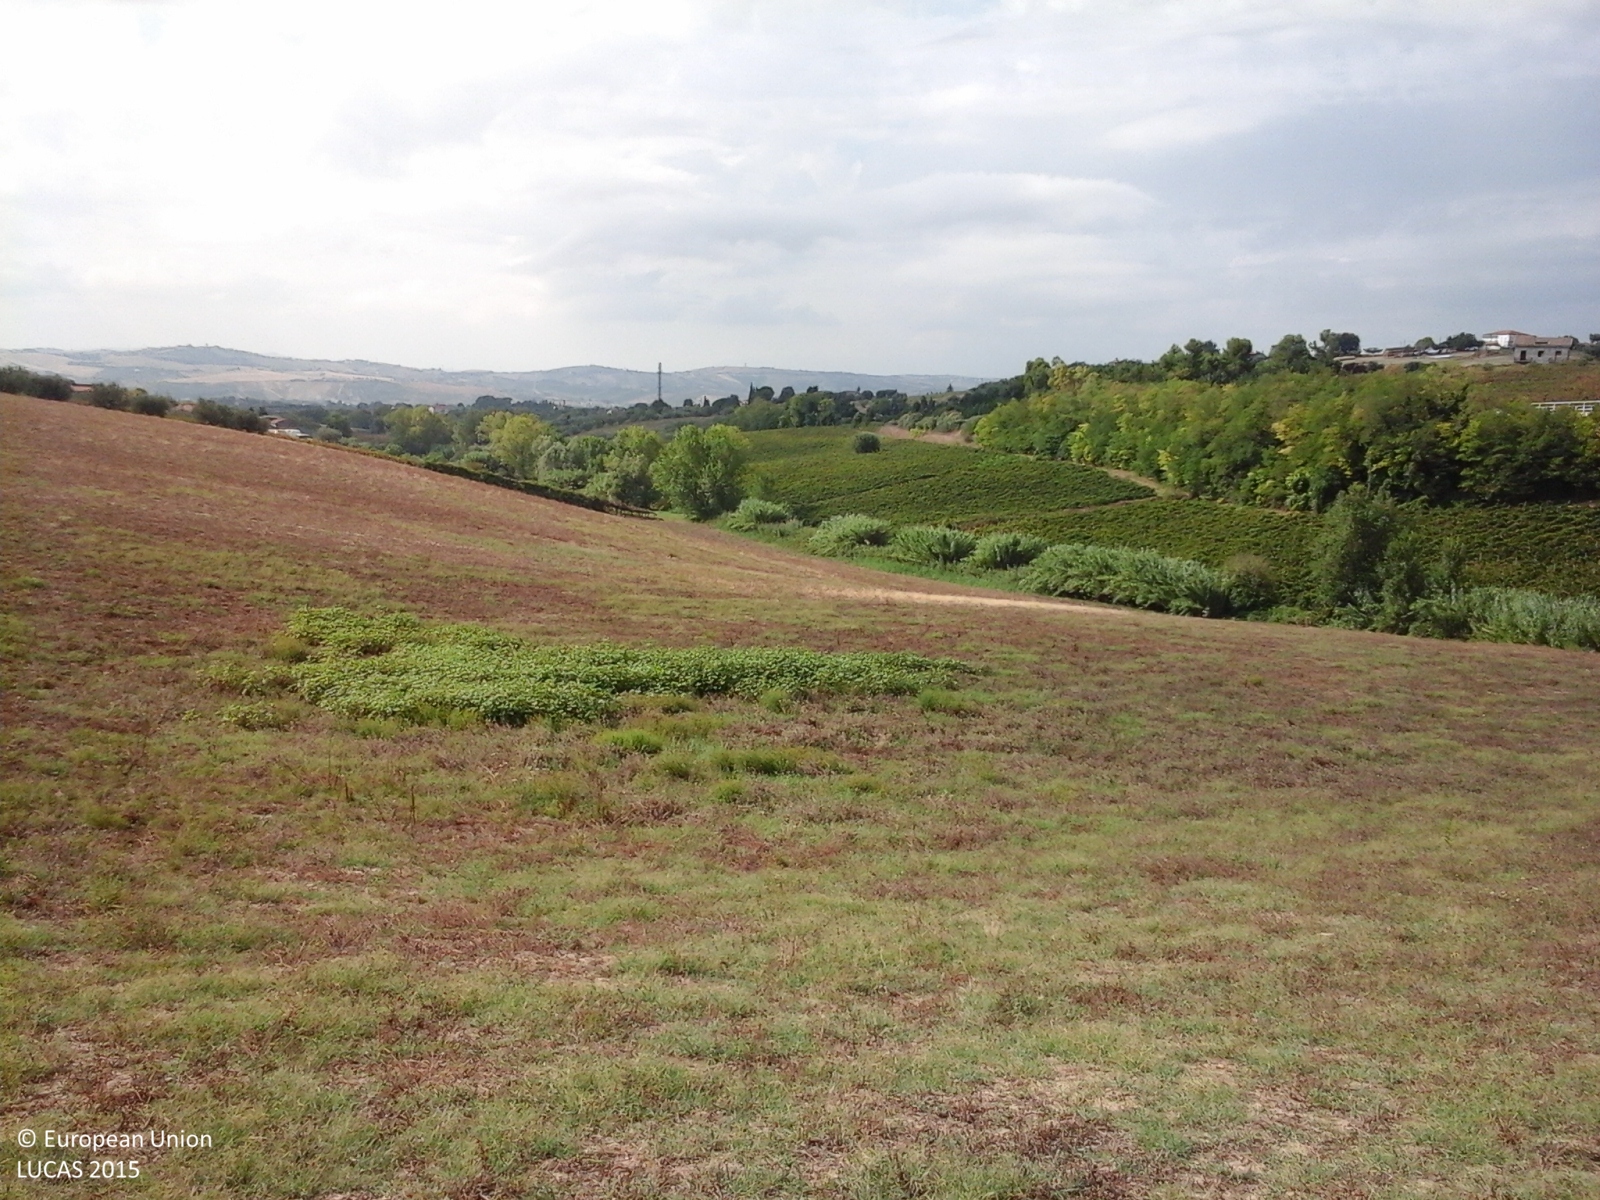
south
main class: Grassland
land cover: Spontaneously vegetated surfaces
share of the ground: > 75 %
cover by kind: herbaceous plants 100 %
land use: Agriculture (excluding fallow land and kitchen gardens)
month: August
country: IT
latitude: 42.7584
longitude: 13.9357
